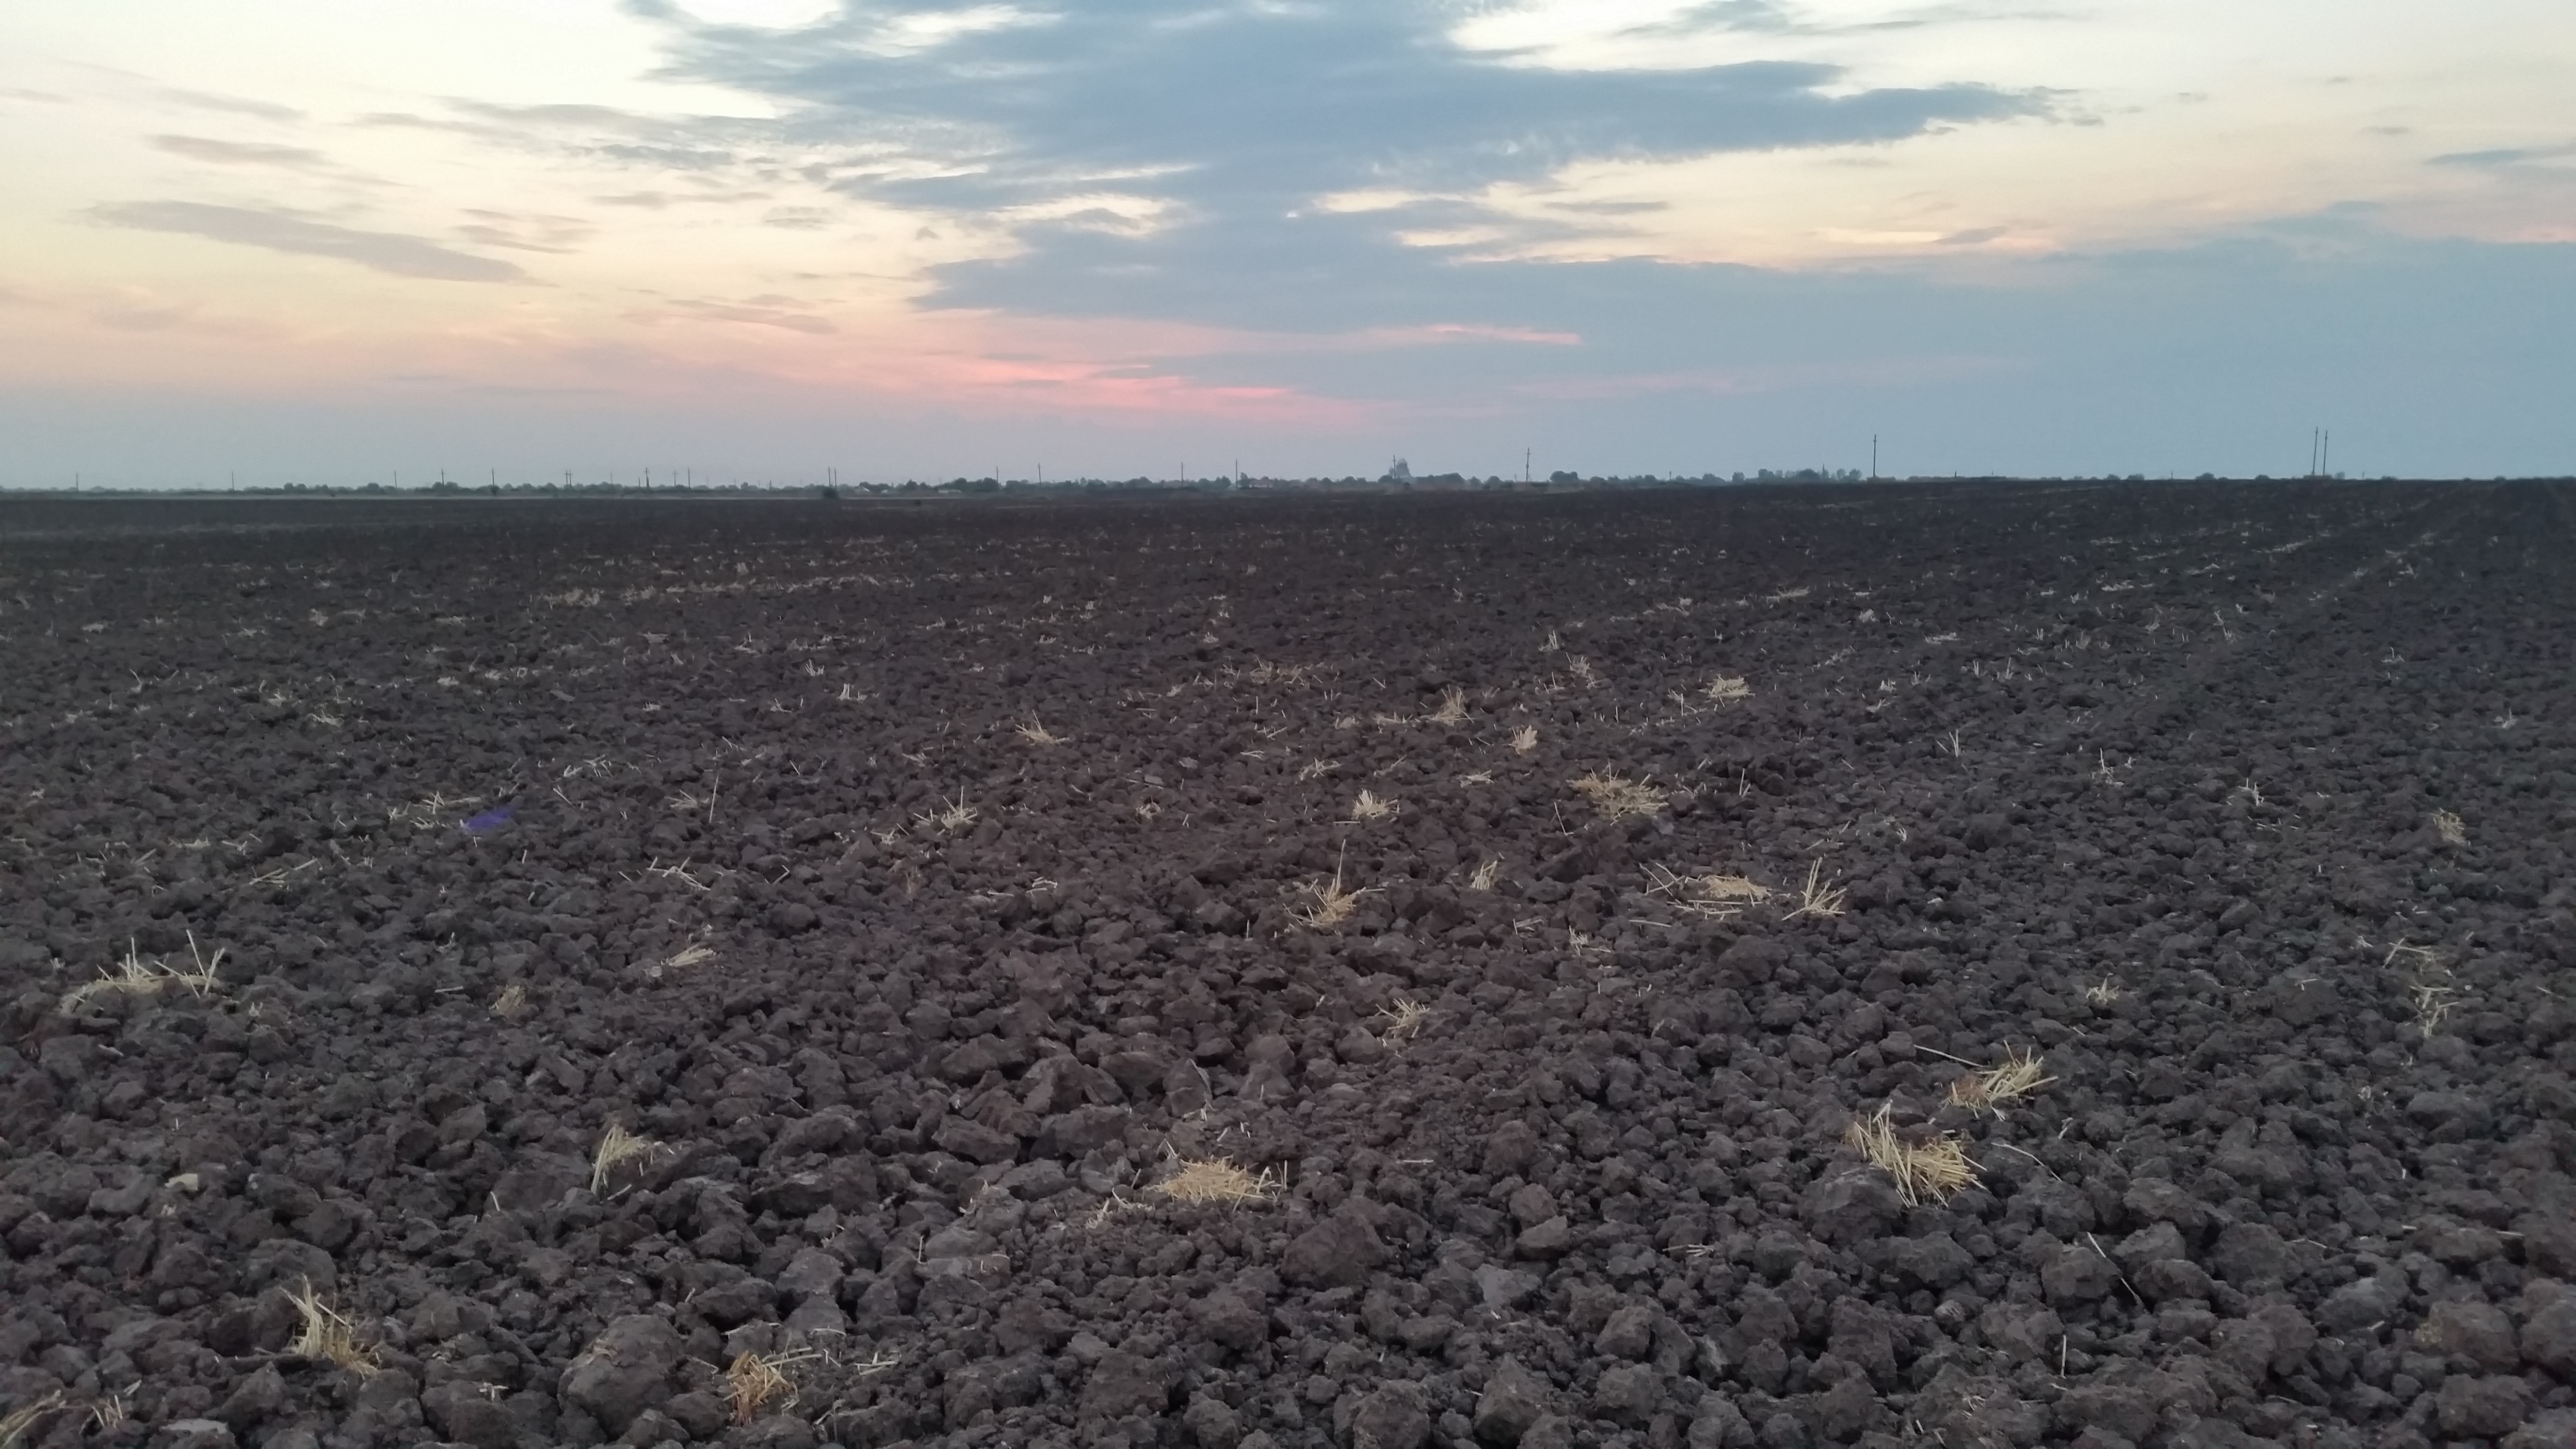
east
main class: Cropland
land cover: Common wheat
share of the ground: < 10 %
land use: Agriculture (excluding fallow land and kitchen gardens)
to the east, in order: Common wheat
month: August
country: RO
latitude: 44.0587
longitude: 23.6969
